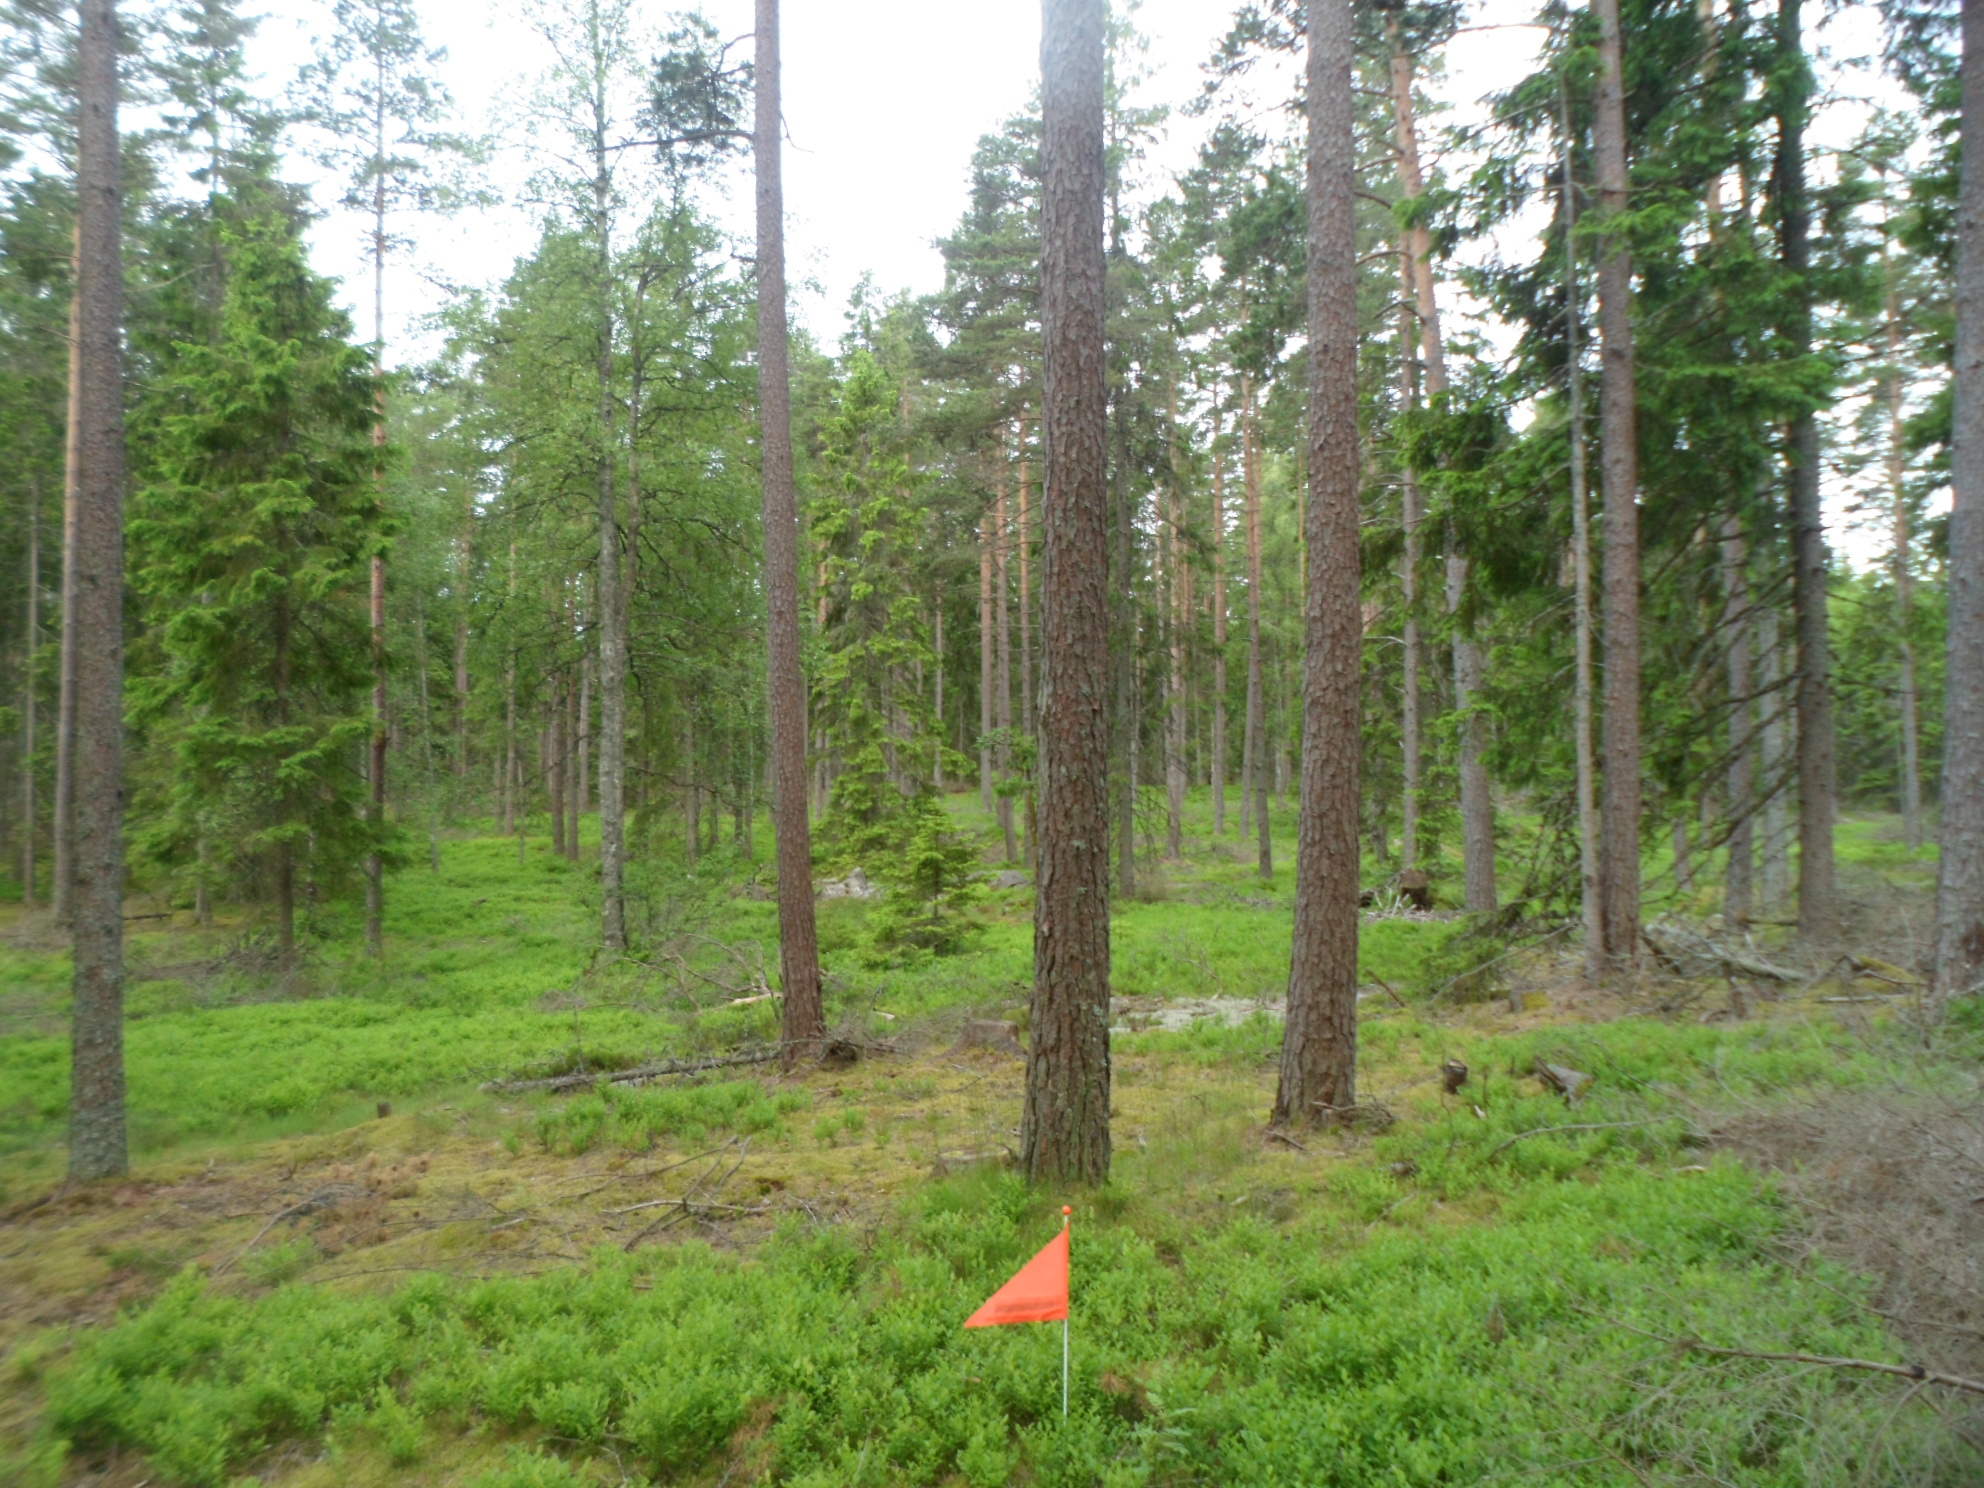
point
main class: Woodland
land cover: Pine dominated coniferous woodland
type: boreal forest
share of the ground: 25 - 50 %
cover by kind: coniferous forest trees 50 %, shrubs 20 %, lichens and mosses 20 %, herbaceous plants 10 %
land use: Forestry
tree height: > 5 m
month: June
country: SE
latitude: 57.0187
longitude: 15.2187
